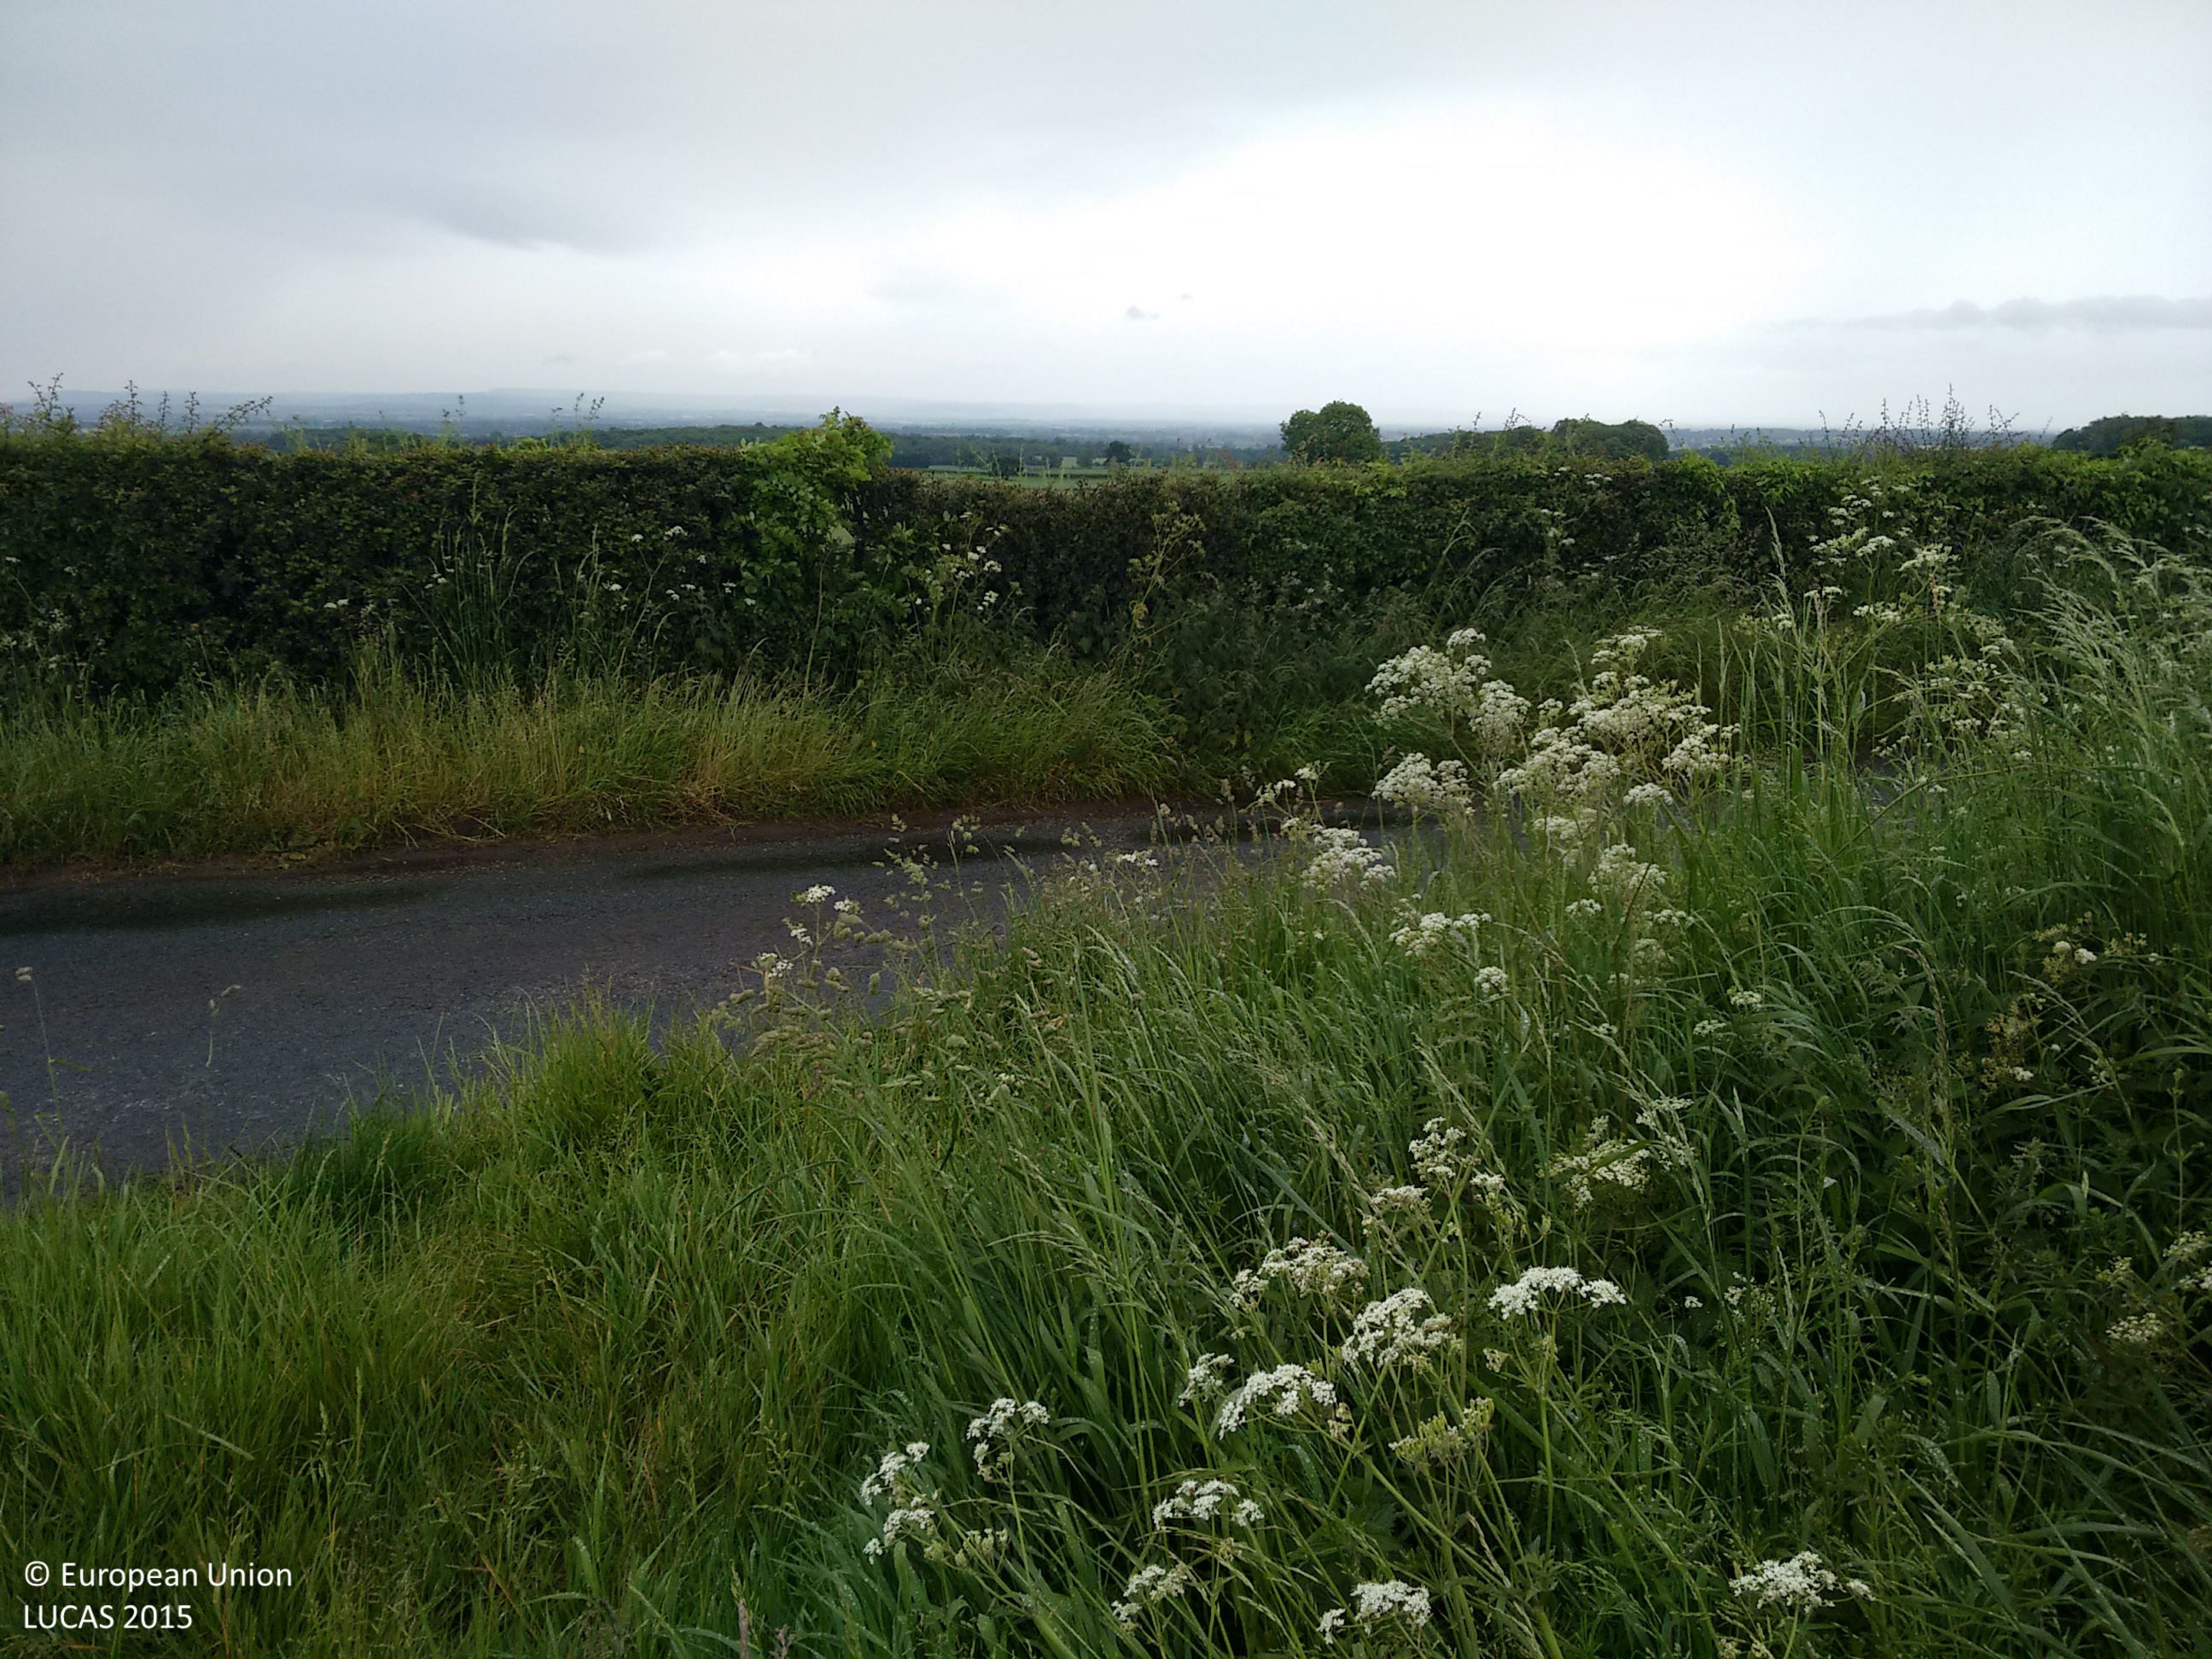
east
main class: Grassland
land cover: Grassland without tree/shrub cover
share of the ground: > 75 %
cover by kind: herbaceous plants 100 %
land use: Agriculture (excluding fallow land and kitchen gardens)
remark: Harvested field
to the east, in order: Grassland without tree/shrub cover; Managed hedges; Fences; Grass margins; Paved roads, cycling and walking lanes; Grass margins; Managed hedges; Common wheat; Managed hedges; Grassland without tree/shrub cover
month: June
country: GB
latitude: 54.2560
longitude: -1.6402
